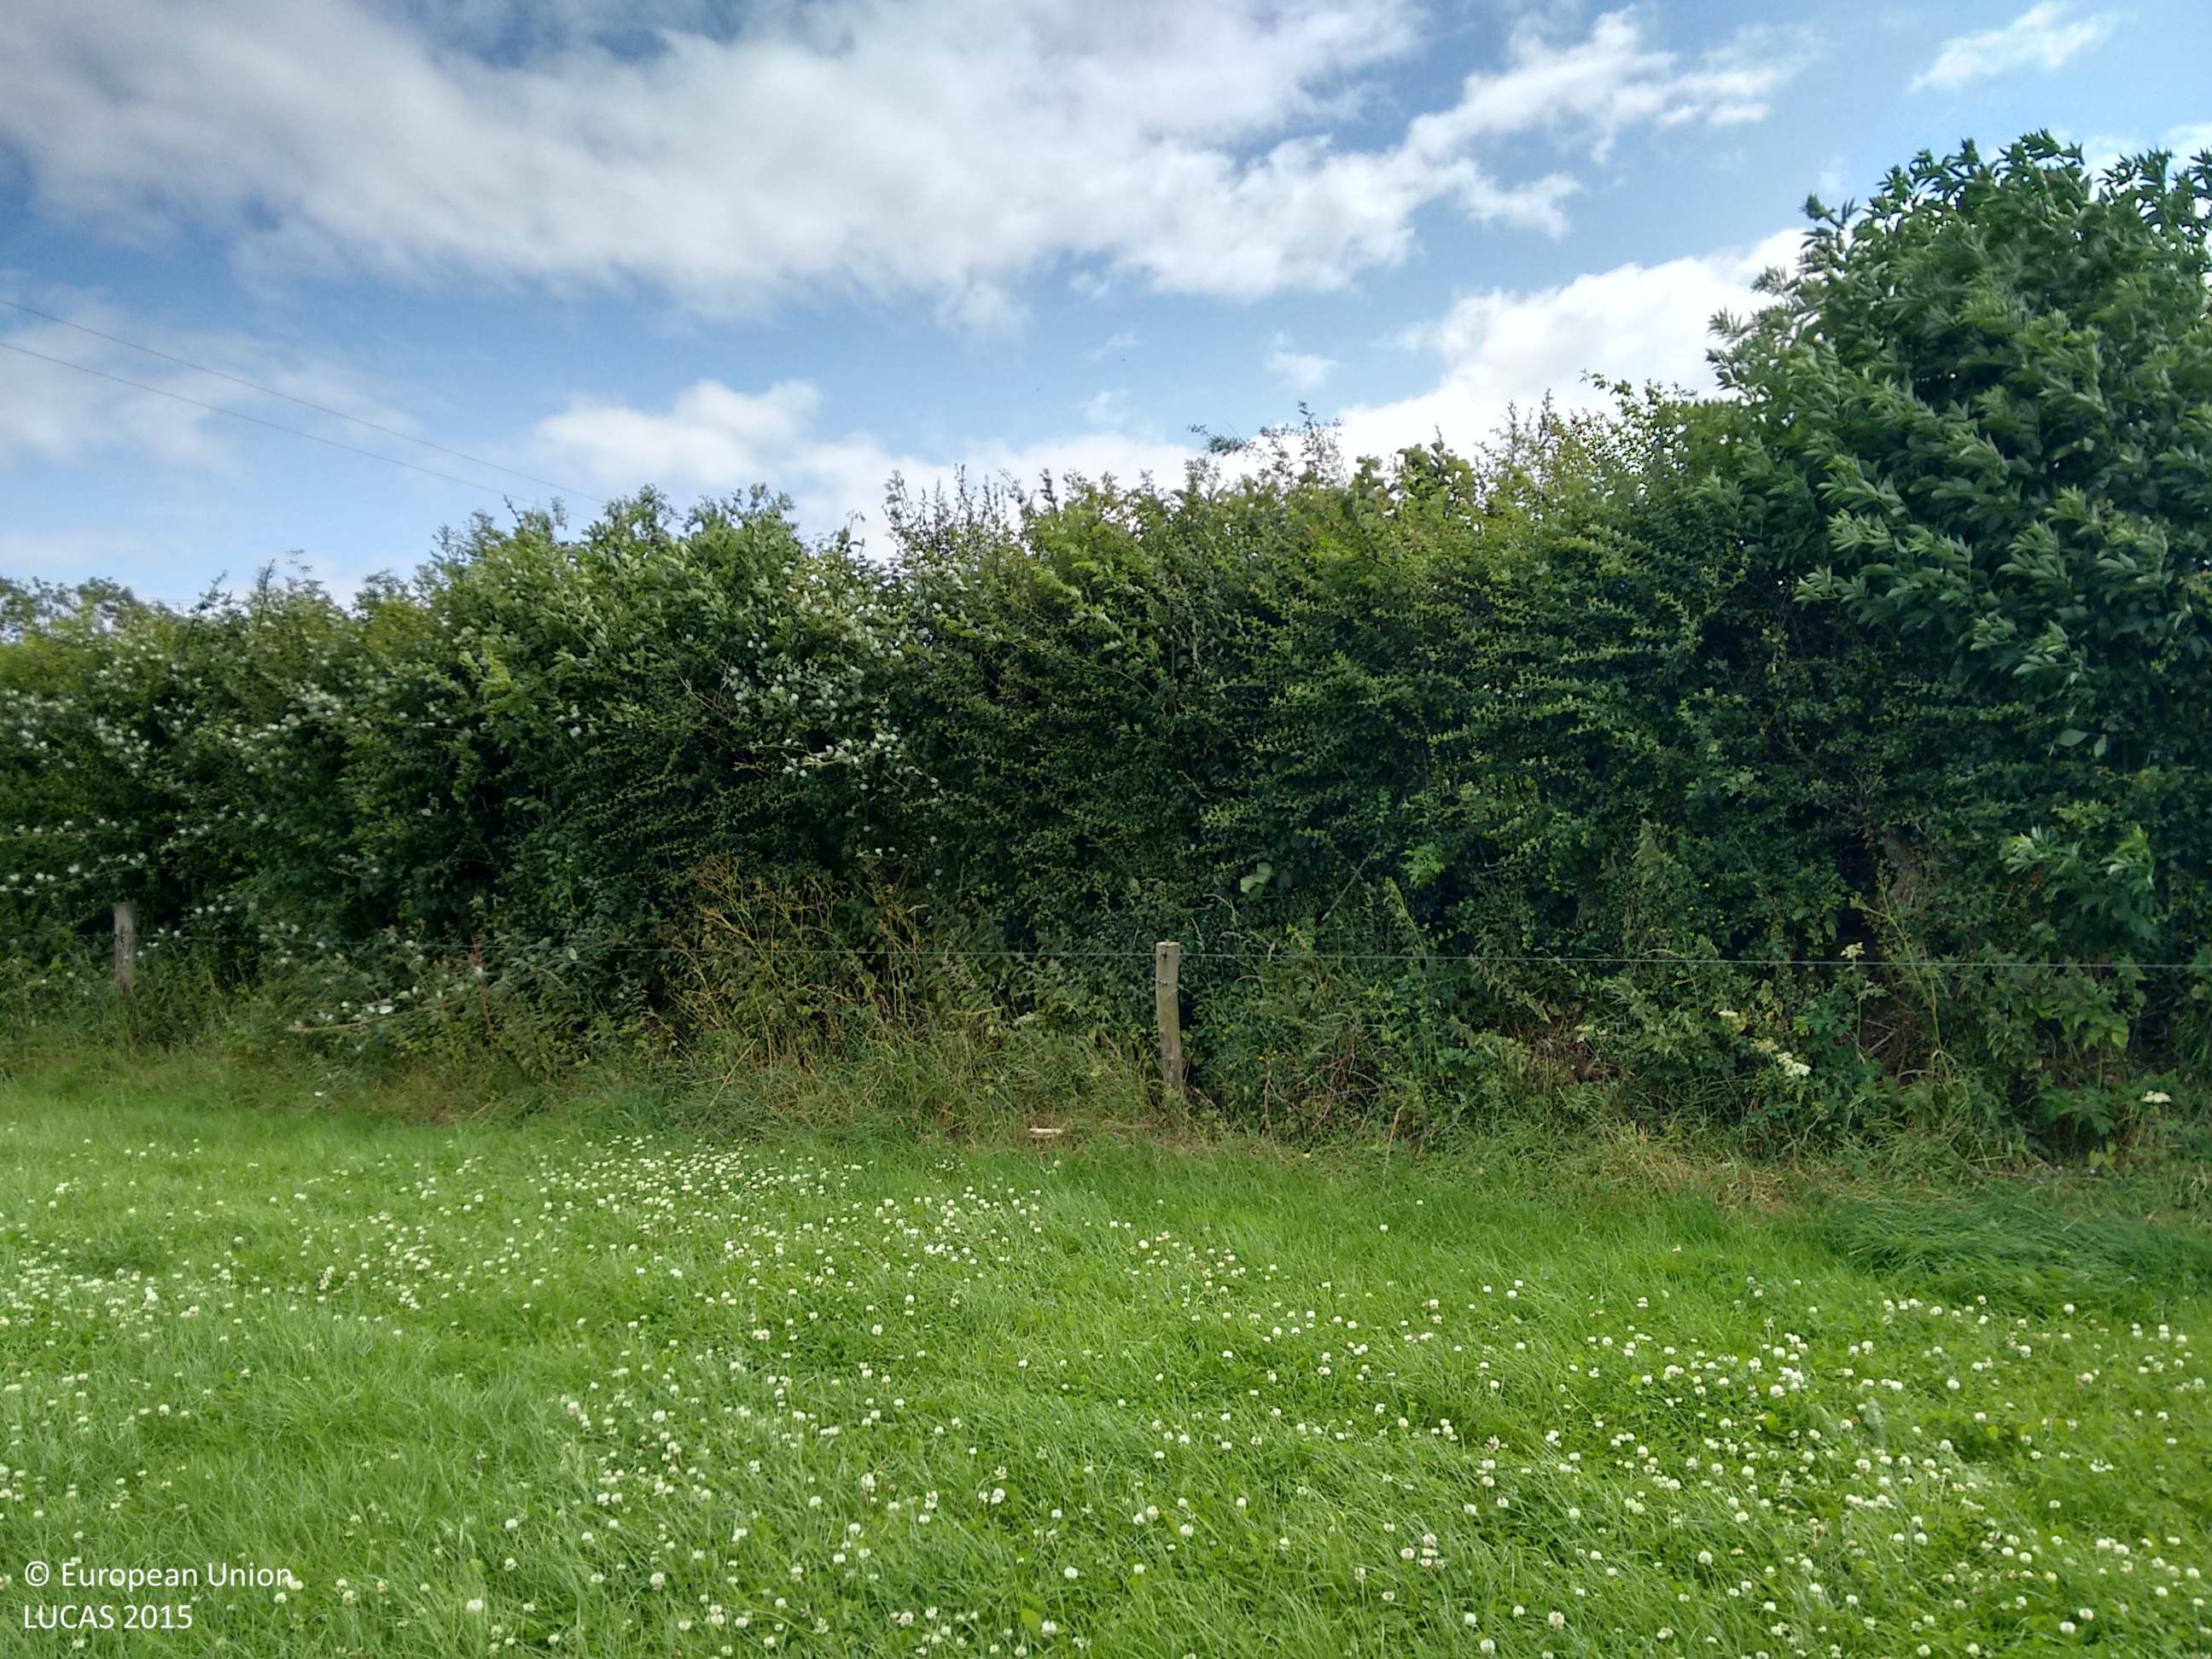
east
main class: Grassland
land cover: Grassland without tree/shrub cover
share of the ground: > 75 %
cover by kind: herbaceous plants 100 %
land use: Agriculture (excluding fallow land and kitchen gardens)
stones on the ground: < 10 %
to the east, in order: Grassland without tree/shrub cover; Fences; Abandoned hedges; Fences; Grassland without tree/shrub cover; Electric lines; Grassland without tree/shrub cover; Fences; Abandoned hedges; Grass margins; Paved roads, cycling and walking lanes; Managed hedges; Dry stone walls; Electric lines; Ditches and canals; Barley; Electric lines; Barley; Spontaneously vegetated surfaces; Abandoned hedges; Fences; Grassland without tree/shrub cover; Artificial constructions in urban areas
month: July
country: IE
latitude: 52.7734
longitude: -7.5171
